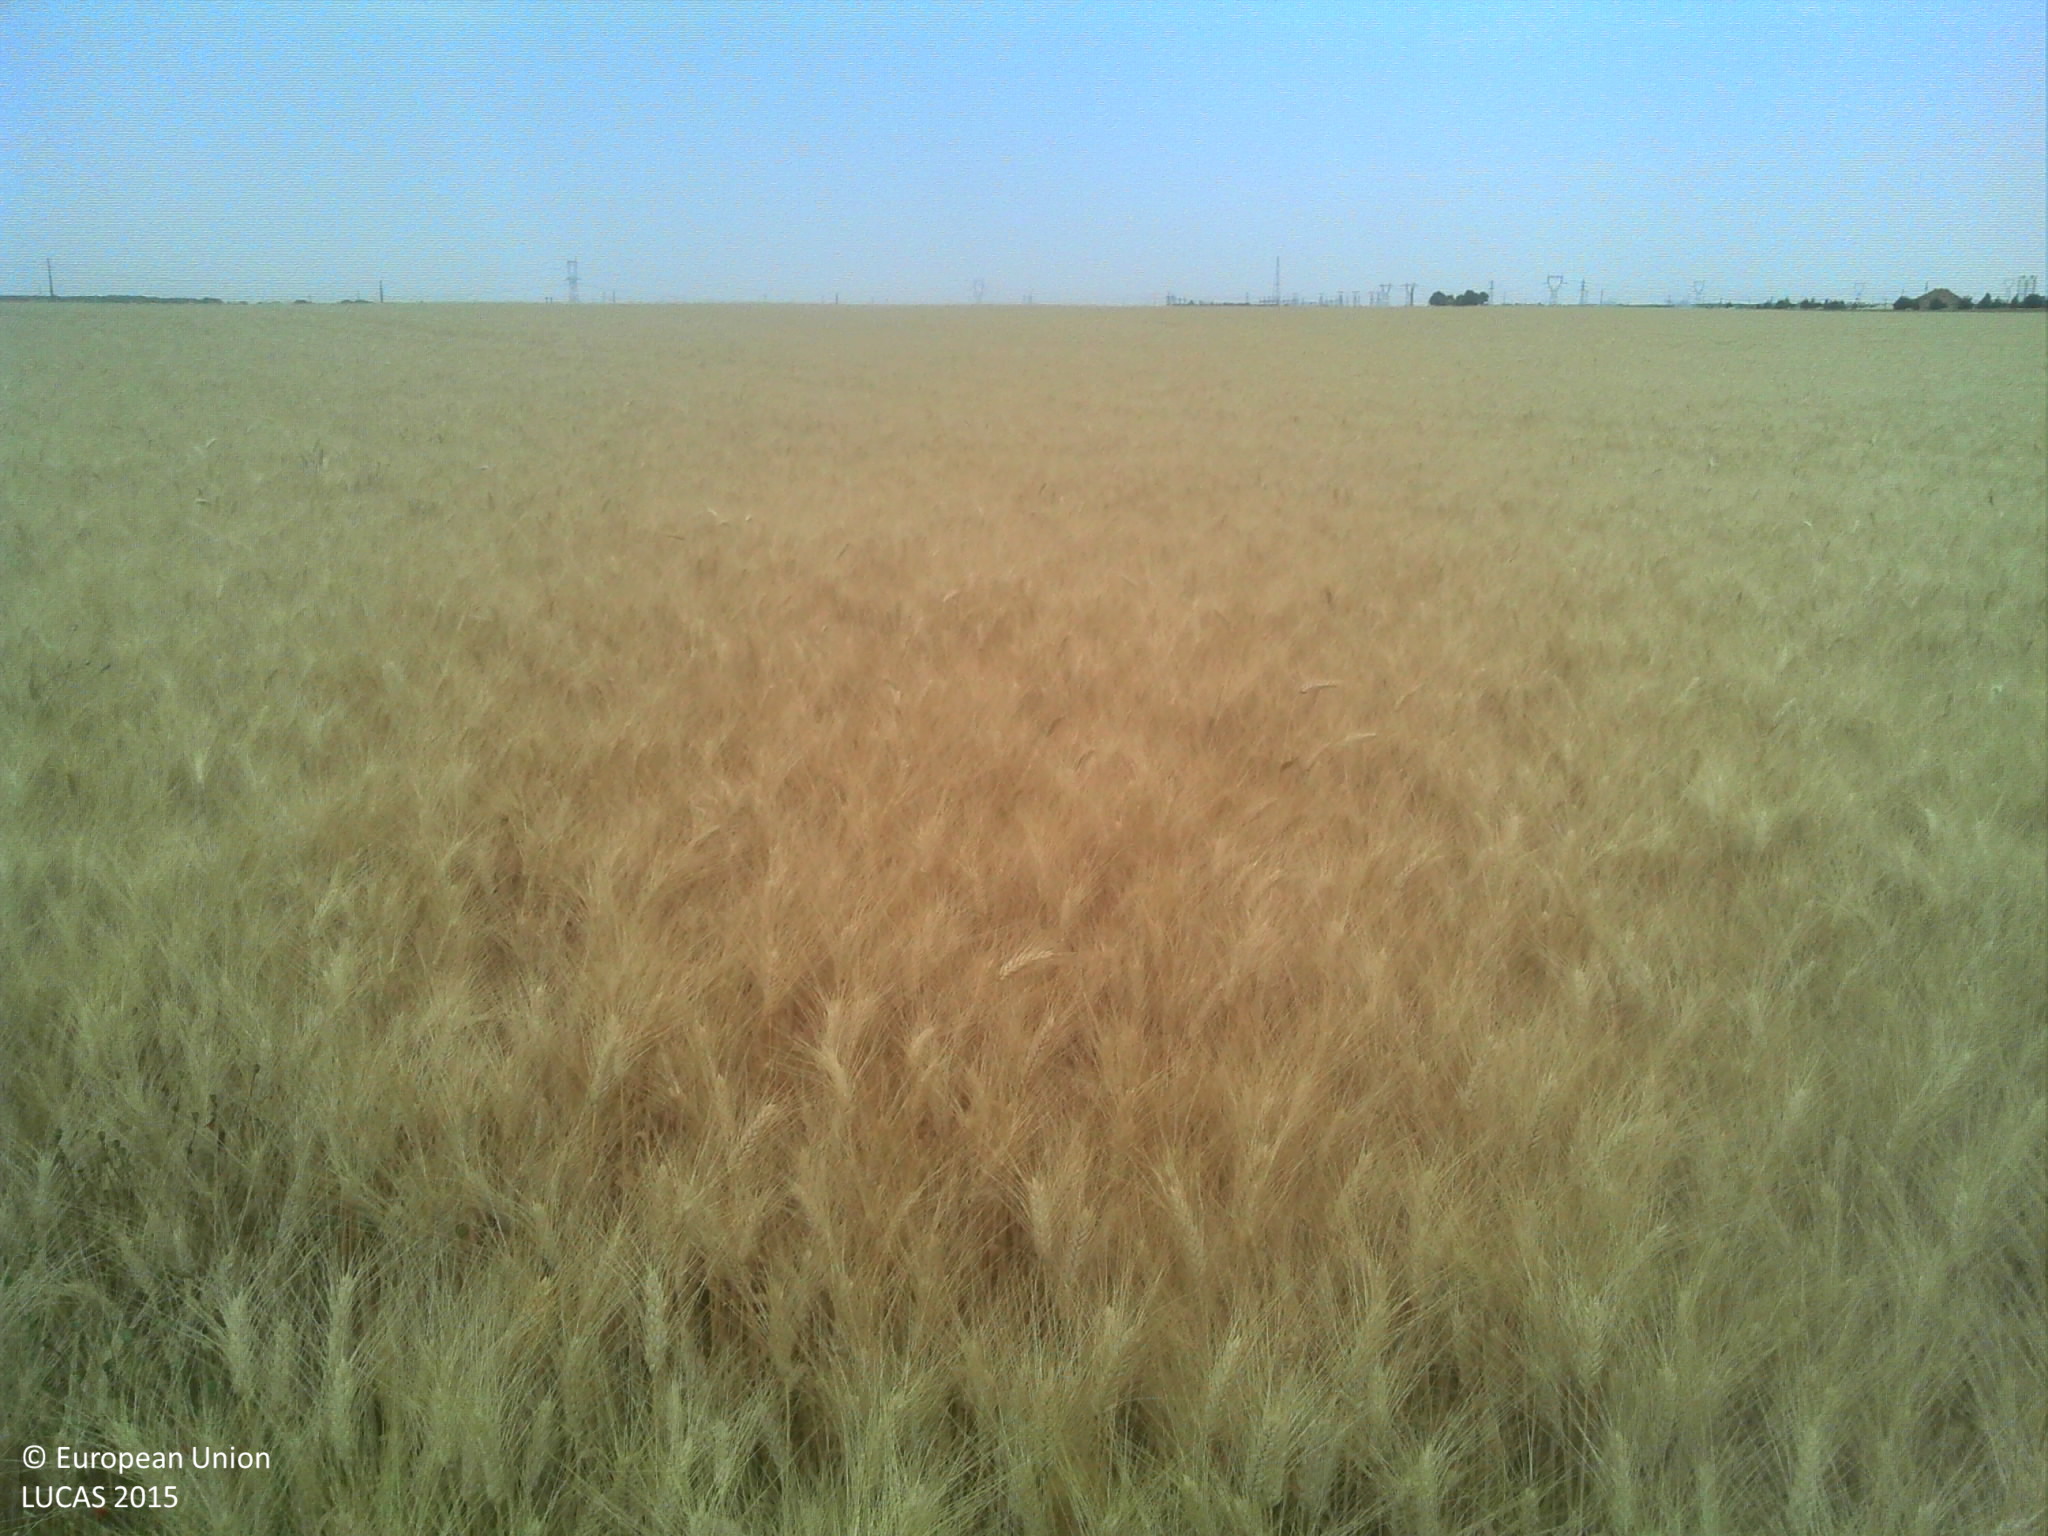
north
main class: Cropland
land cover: Durum wheat
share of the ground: > 75 %
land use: Agriculture (excluding fallow land and kitchen gardens)
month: July
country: FR
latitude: 47.6274
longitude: 1.3214
